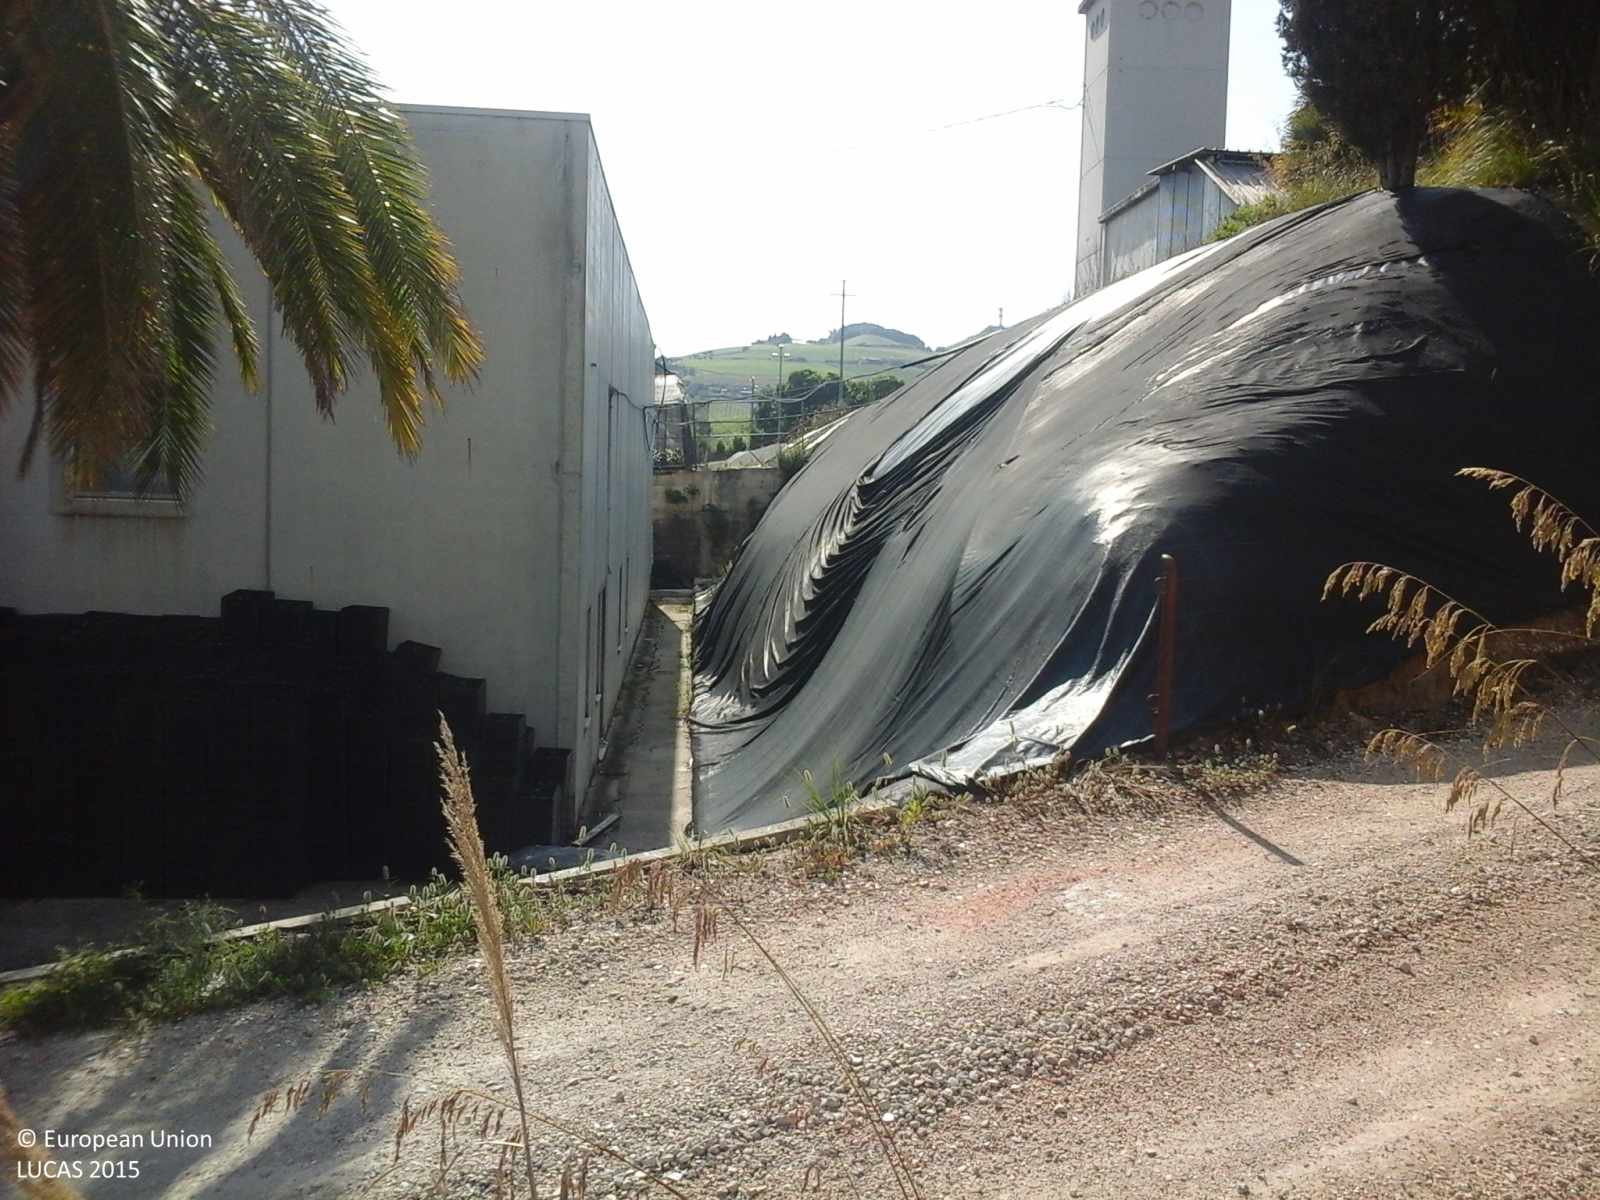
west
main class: Grassland
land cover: Grassland without tree/shrub cover
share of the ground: > 75 %
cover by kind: herbaceous plants 100 %
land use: Abandoned areas
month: May
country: IT
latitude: 42.9613
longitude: 13.8268
